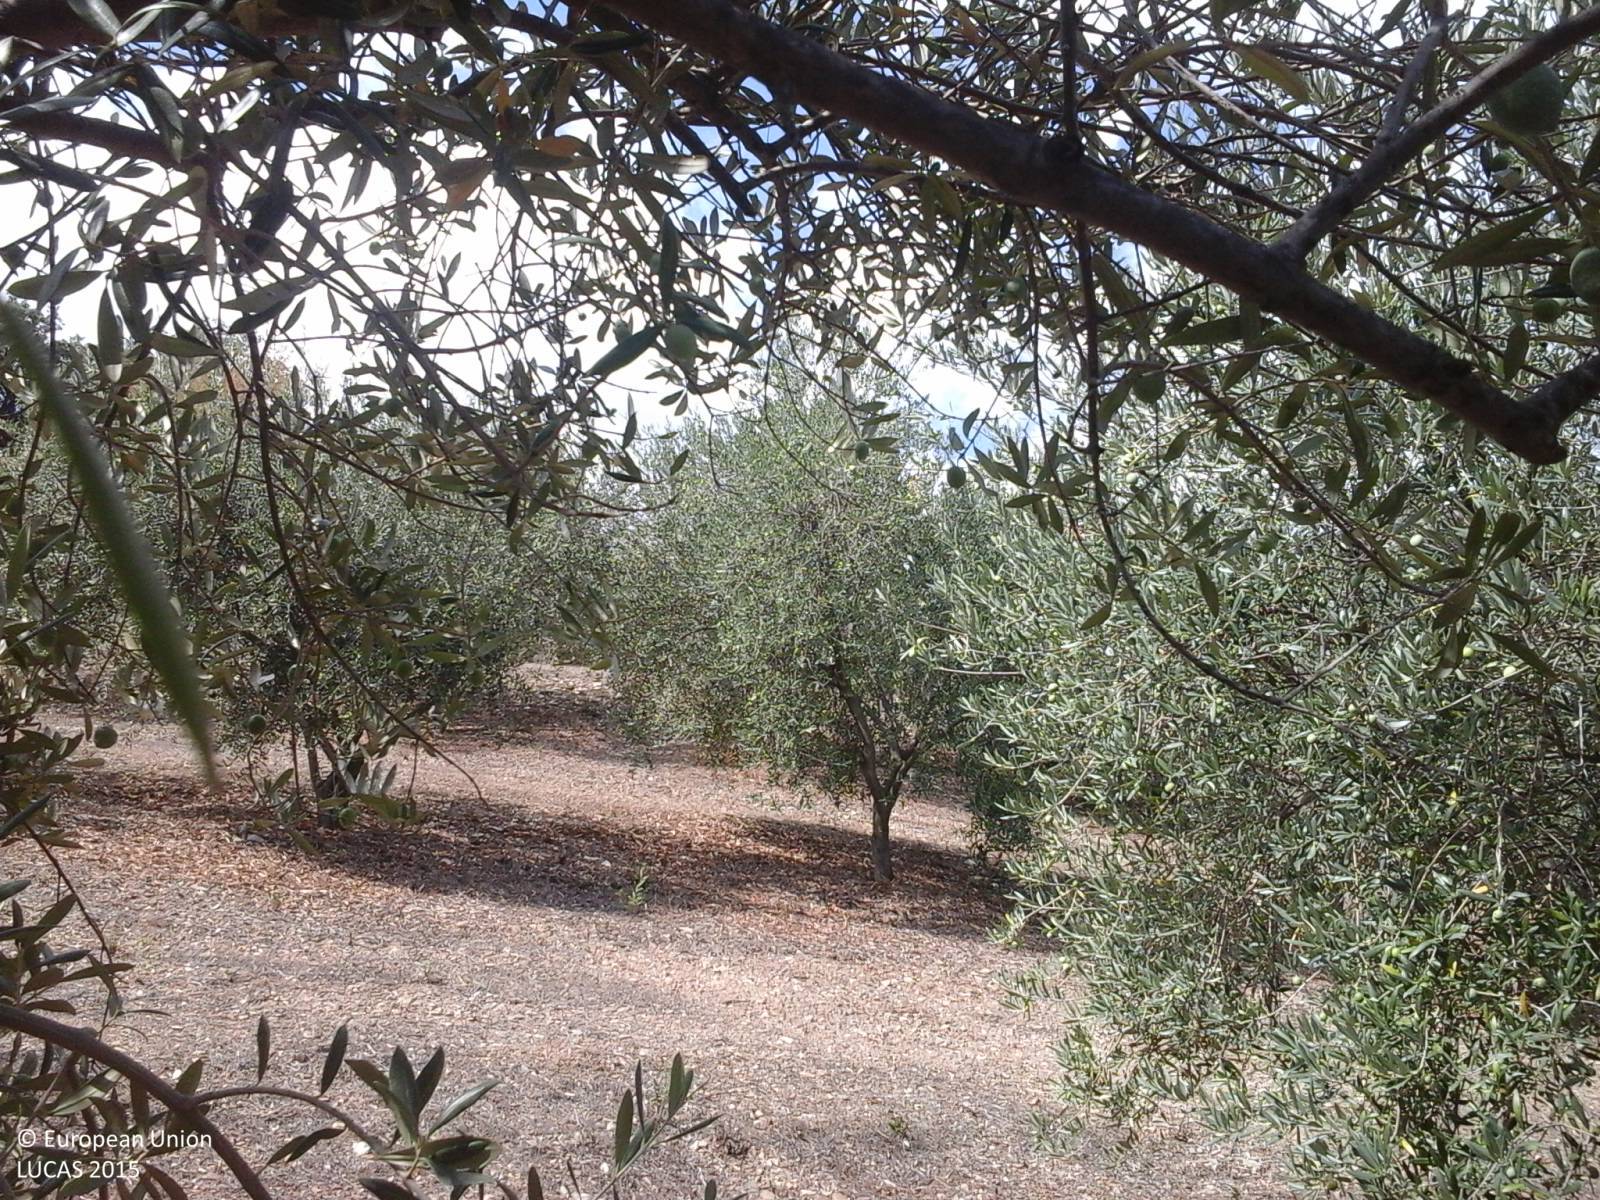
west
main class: Cropland
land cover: Olive groves
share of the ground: > 75 %
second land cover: Spontaneously vegetated surfaces
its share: > 75 %
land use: Agriculture (excluding fallow land and kitchen gardens)
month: September
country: IT
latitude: 39.7050
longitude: 9.5709
